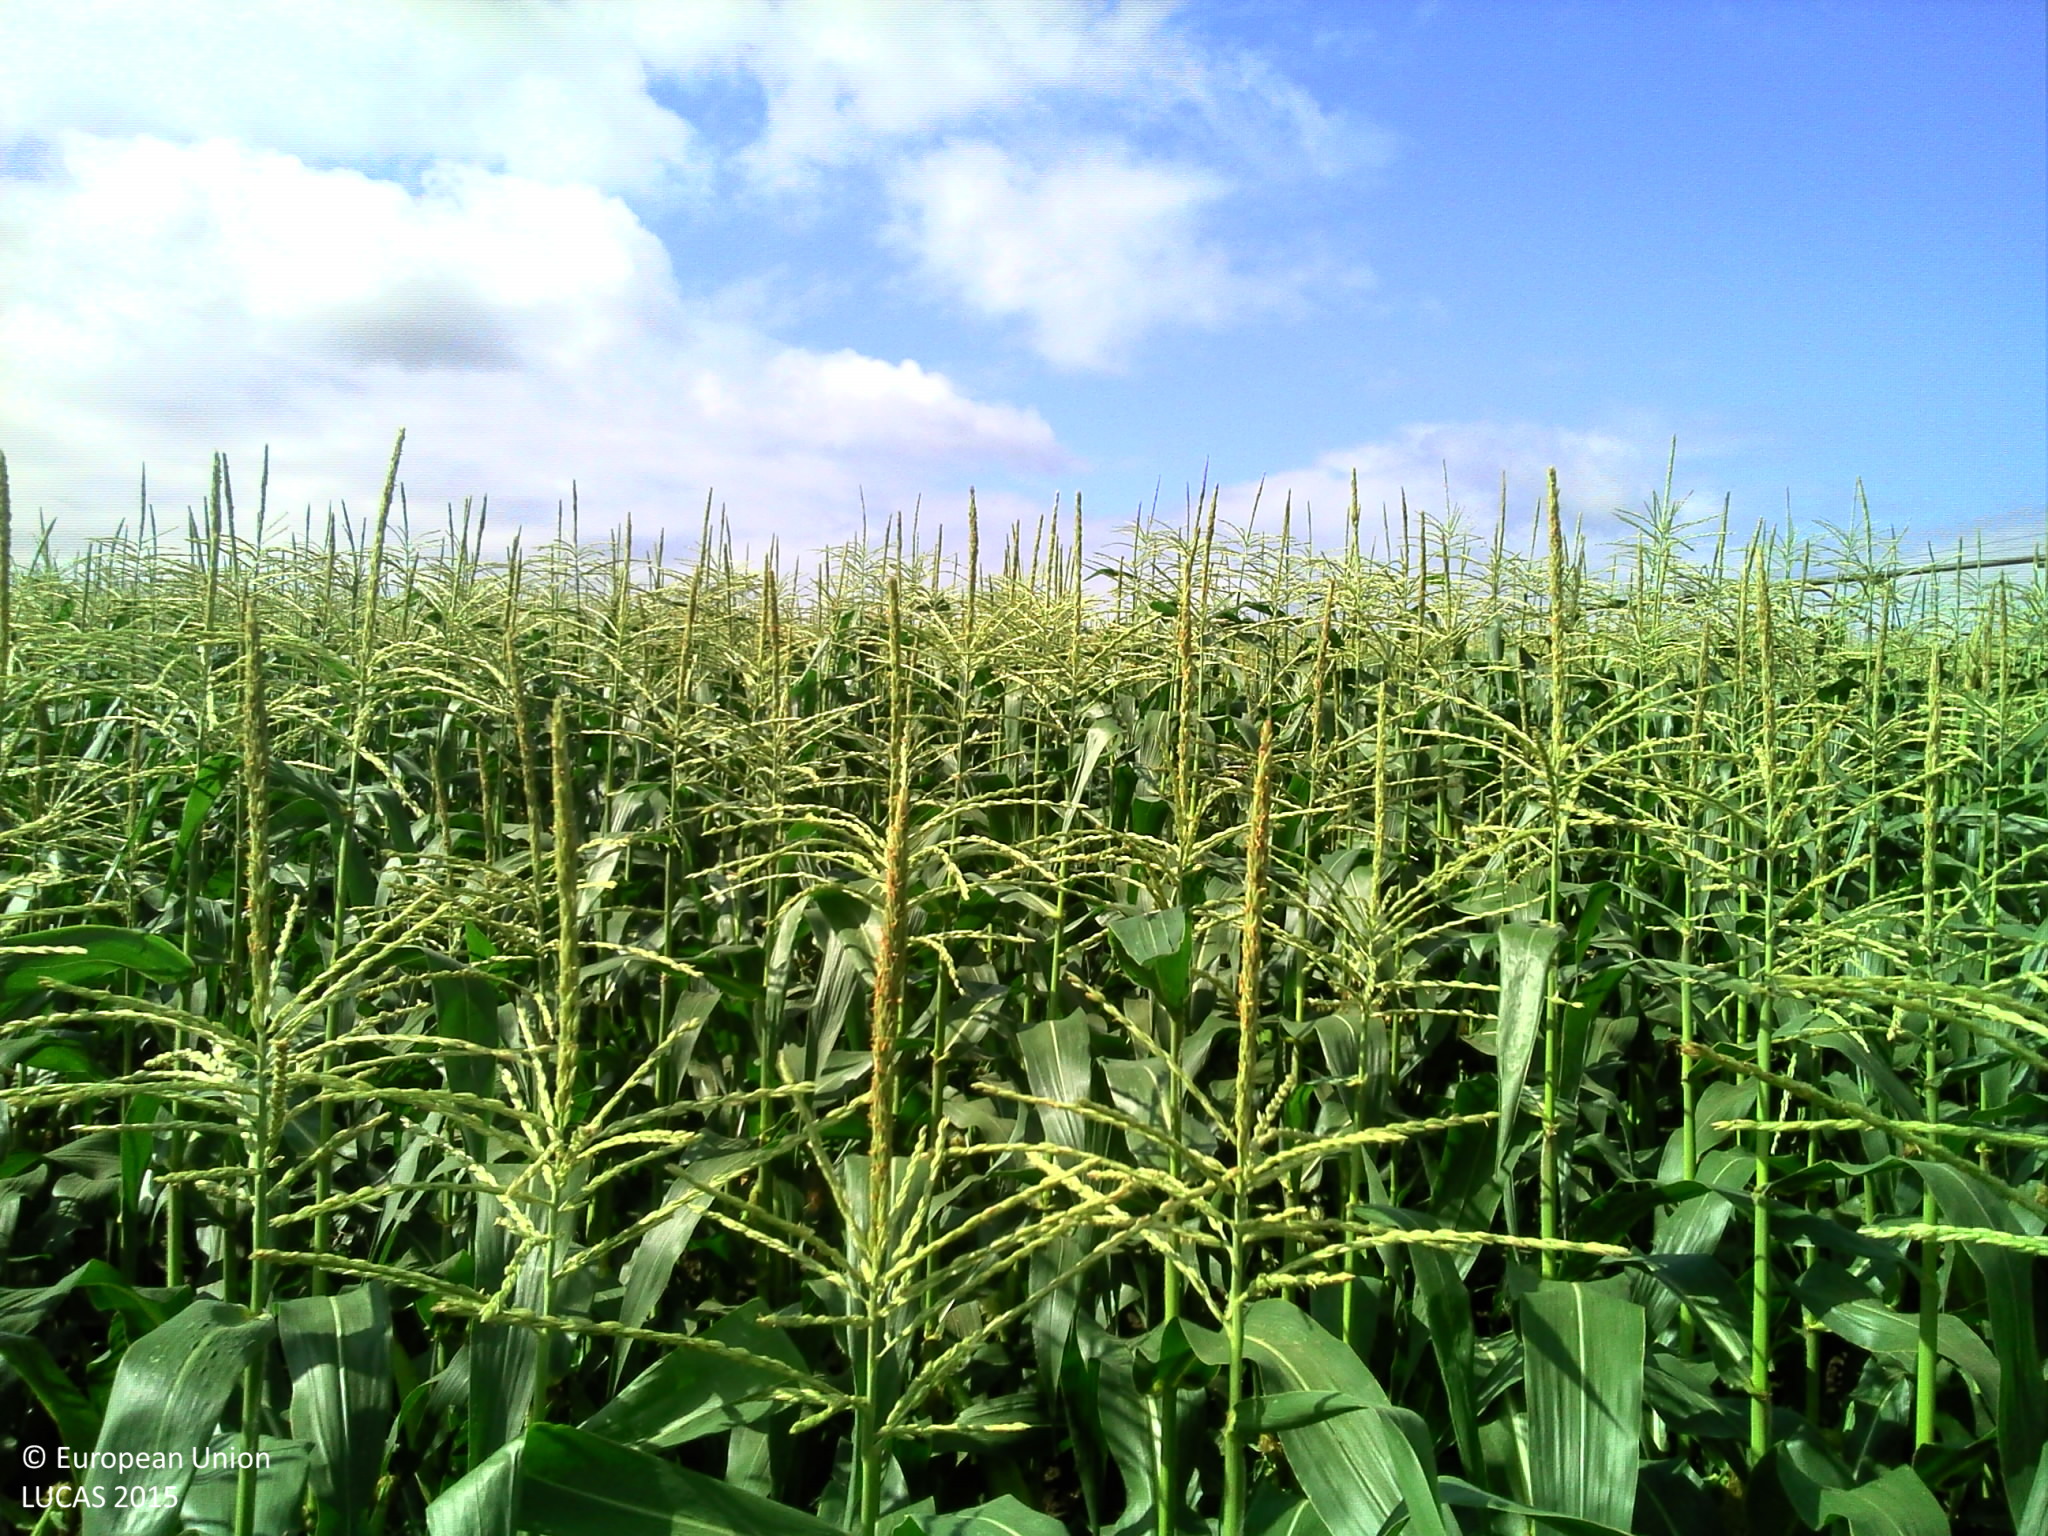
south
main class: Cropland
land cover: Maize
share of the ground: > 75 %
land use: Agriculture (excluding fallow land and kitchen gardens)
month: July
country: FR
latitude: 43.8452
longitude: -0.7483
